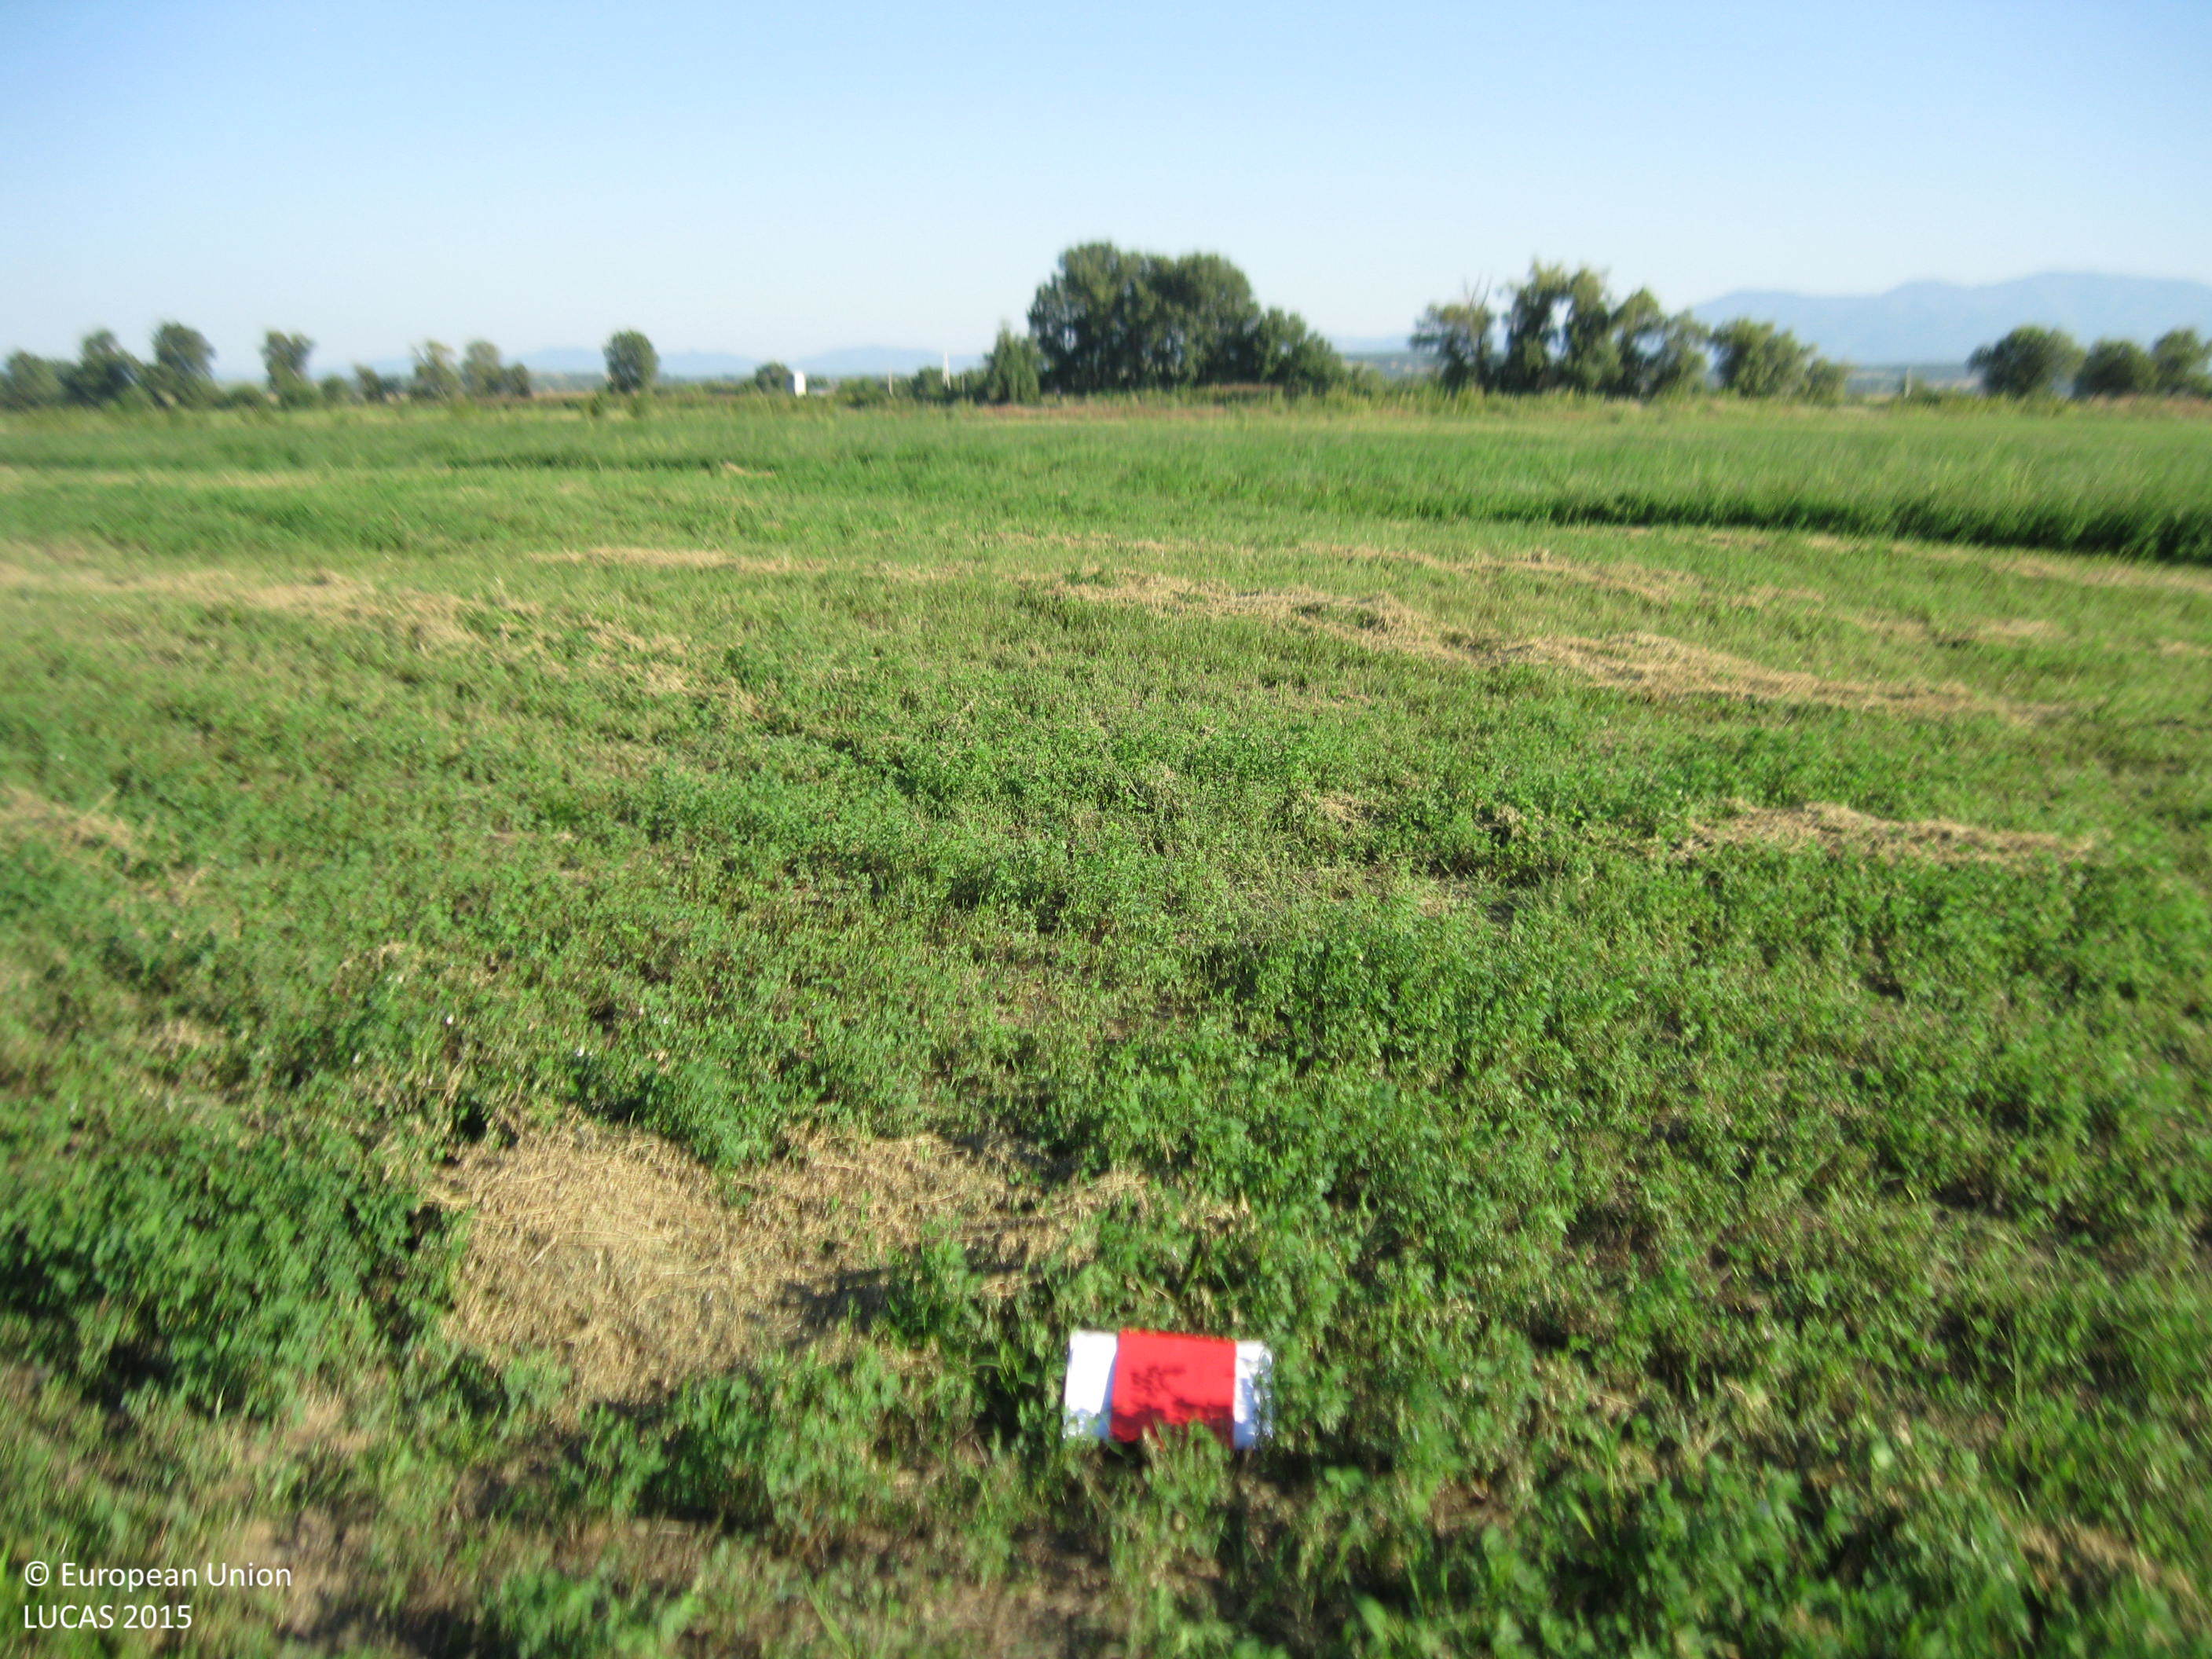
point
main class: Cropland
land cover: Lucerne
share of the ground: > 75 %
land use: Agriculture (excluding fallow land and kitchen gardens)
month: September
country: BG
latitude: 42.0504
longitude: 24.9515
